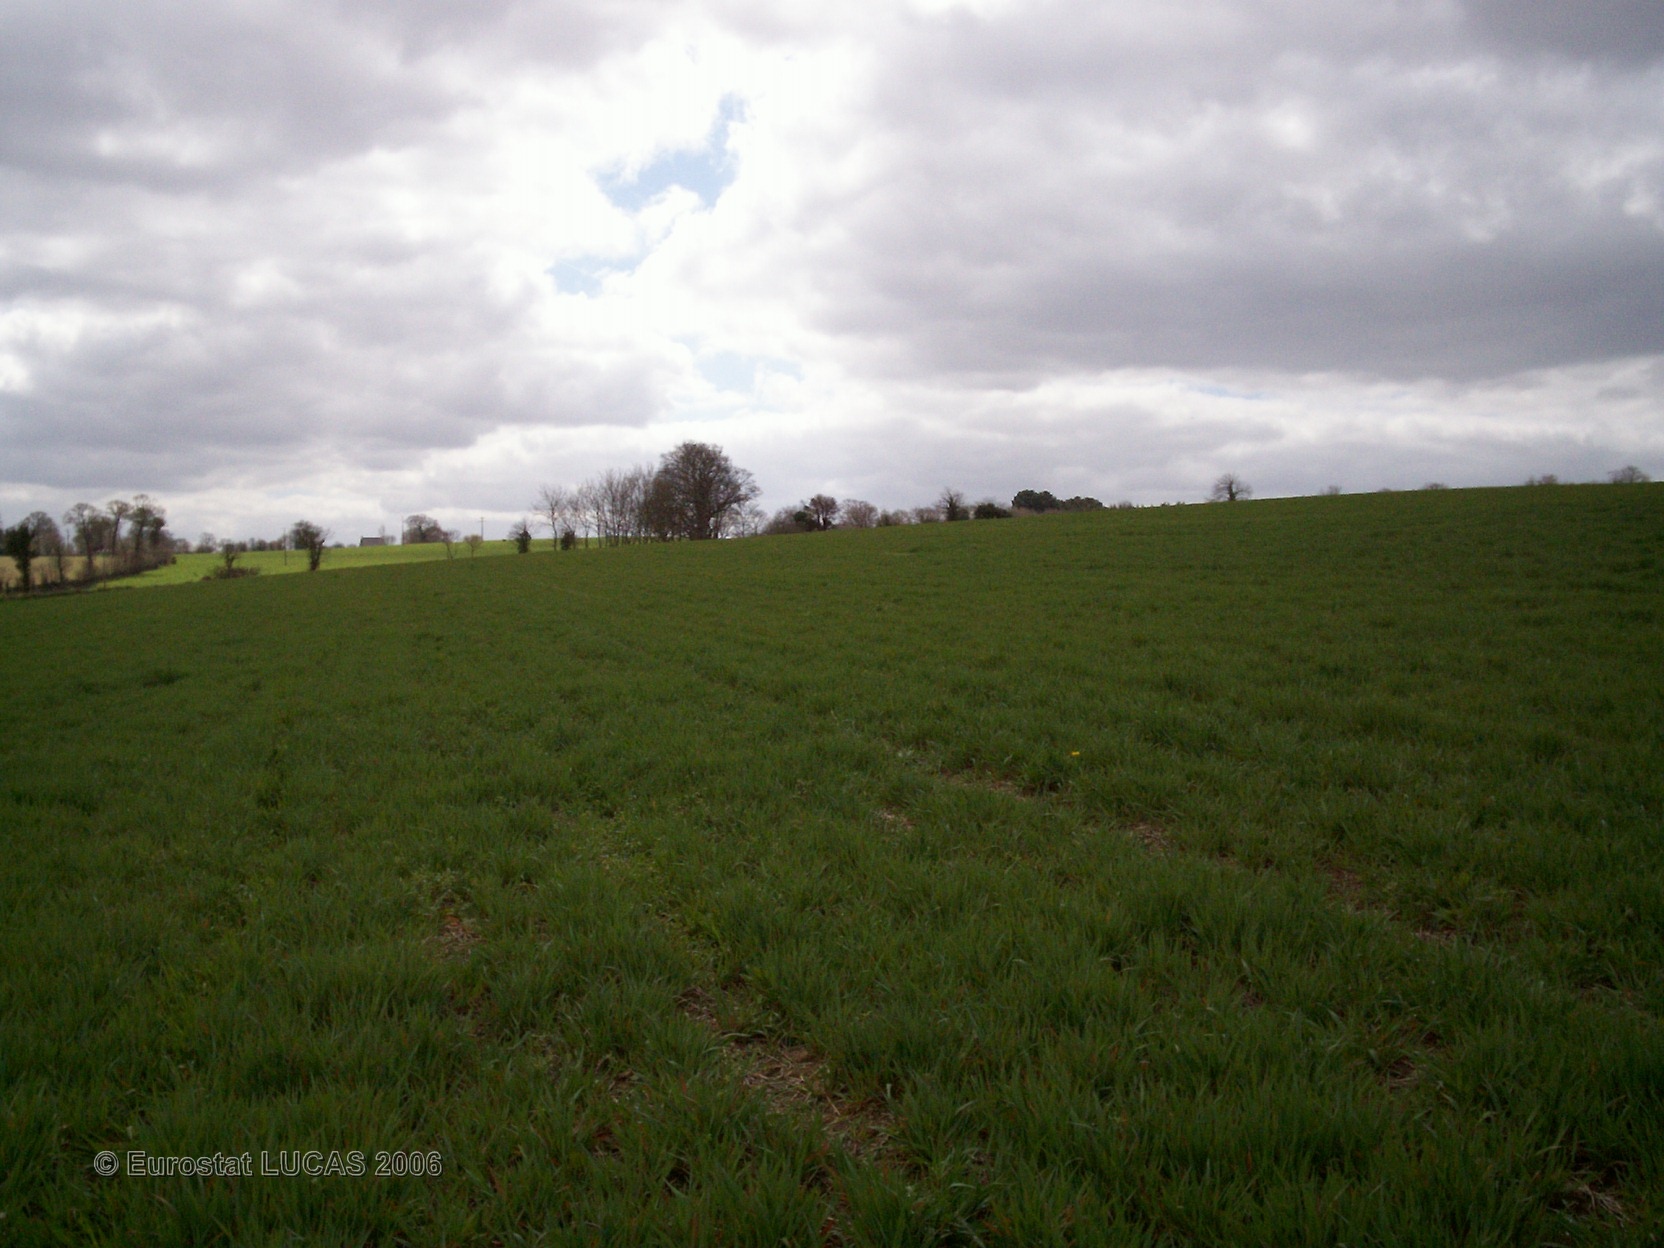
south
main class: Cropland
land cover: Oats
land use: Agriculture (excluding fallow land and kitchen gardens)
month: April
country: FR
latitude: 48.2321
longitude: -3.6101
